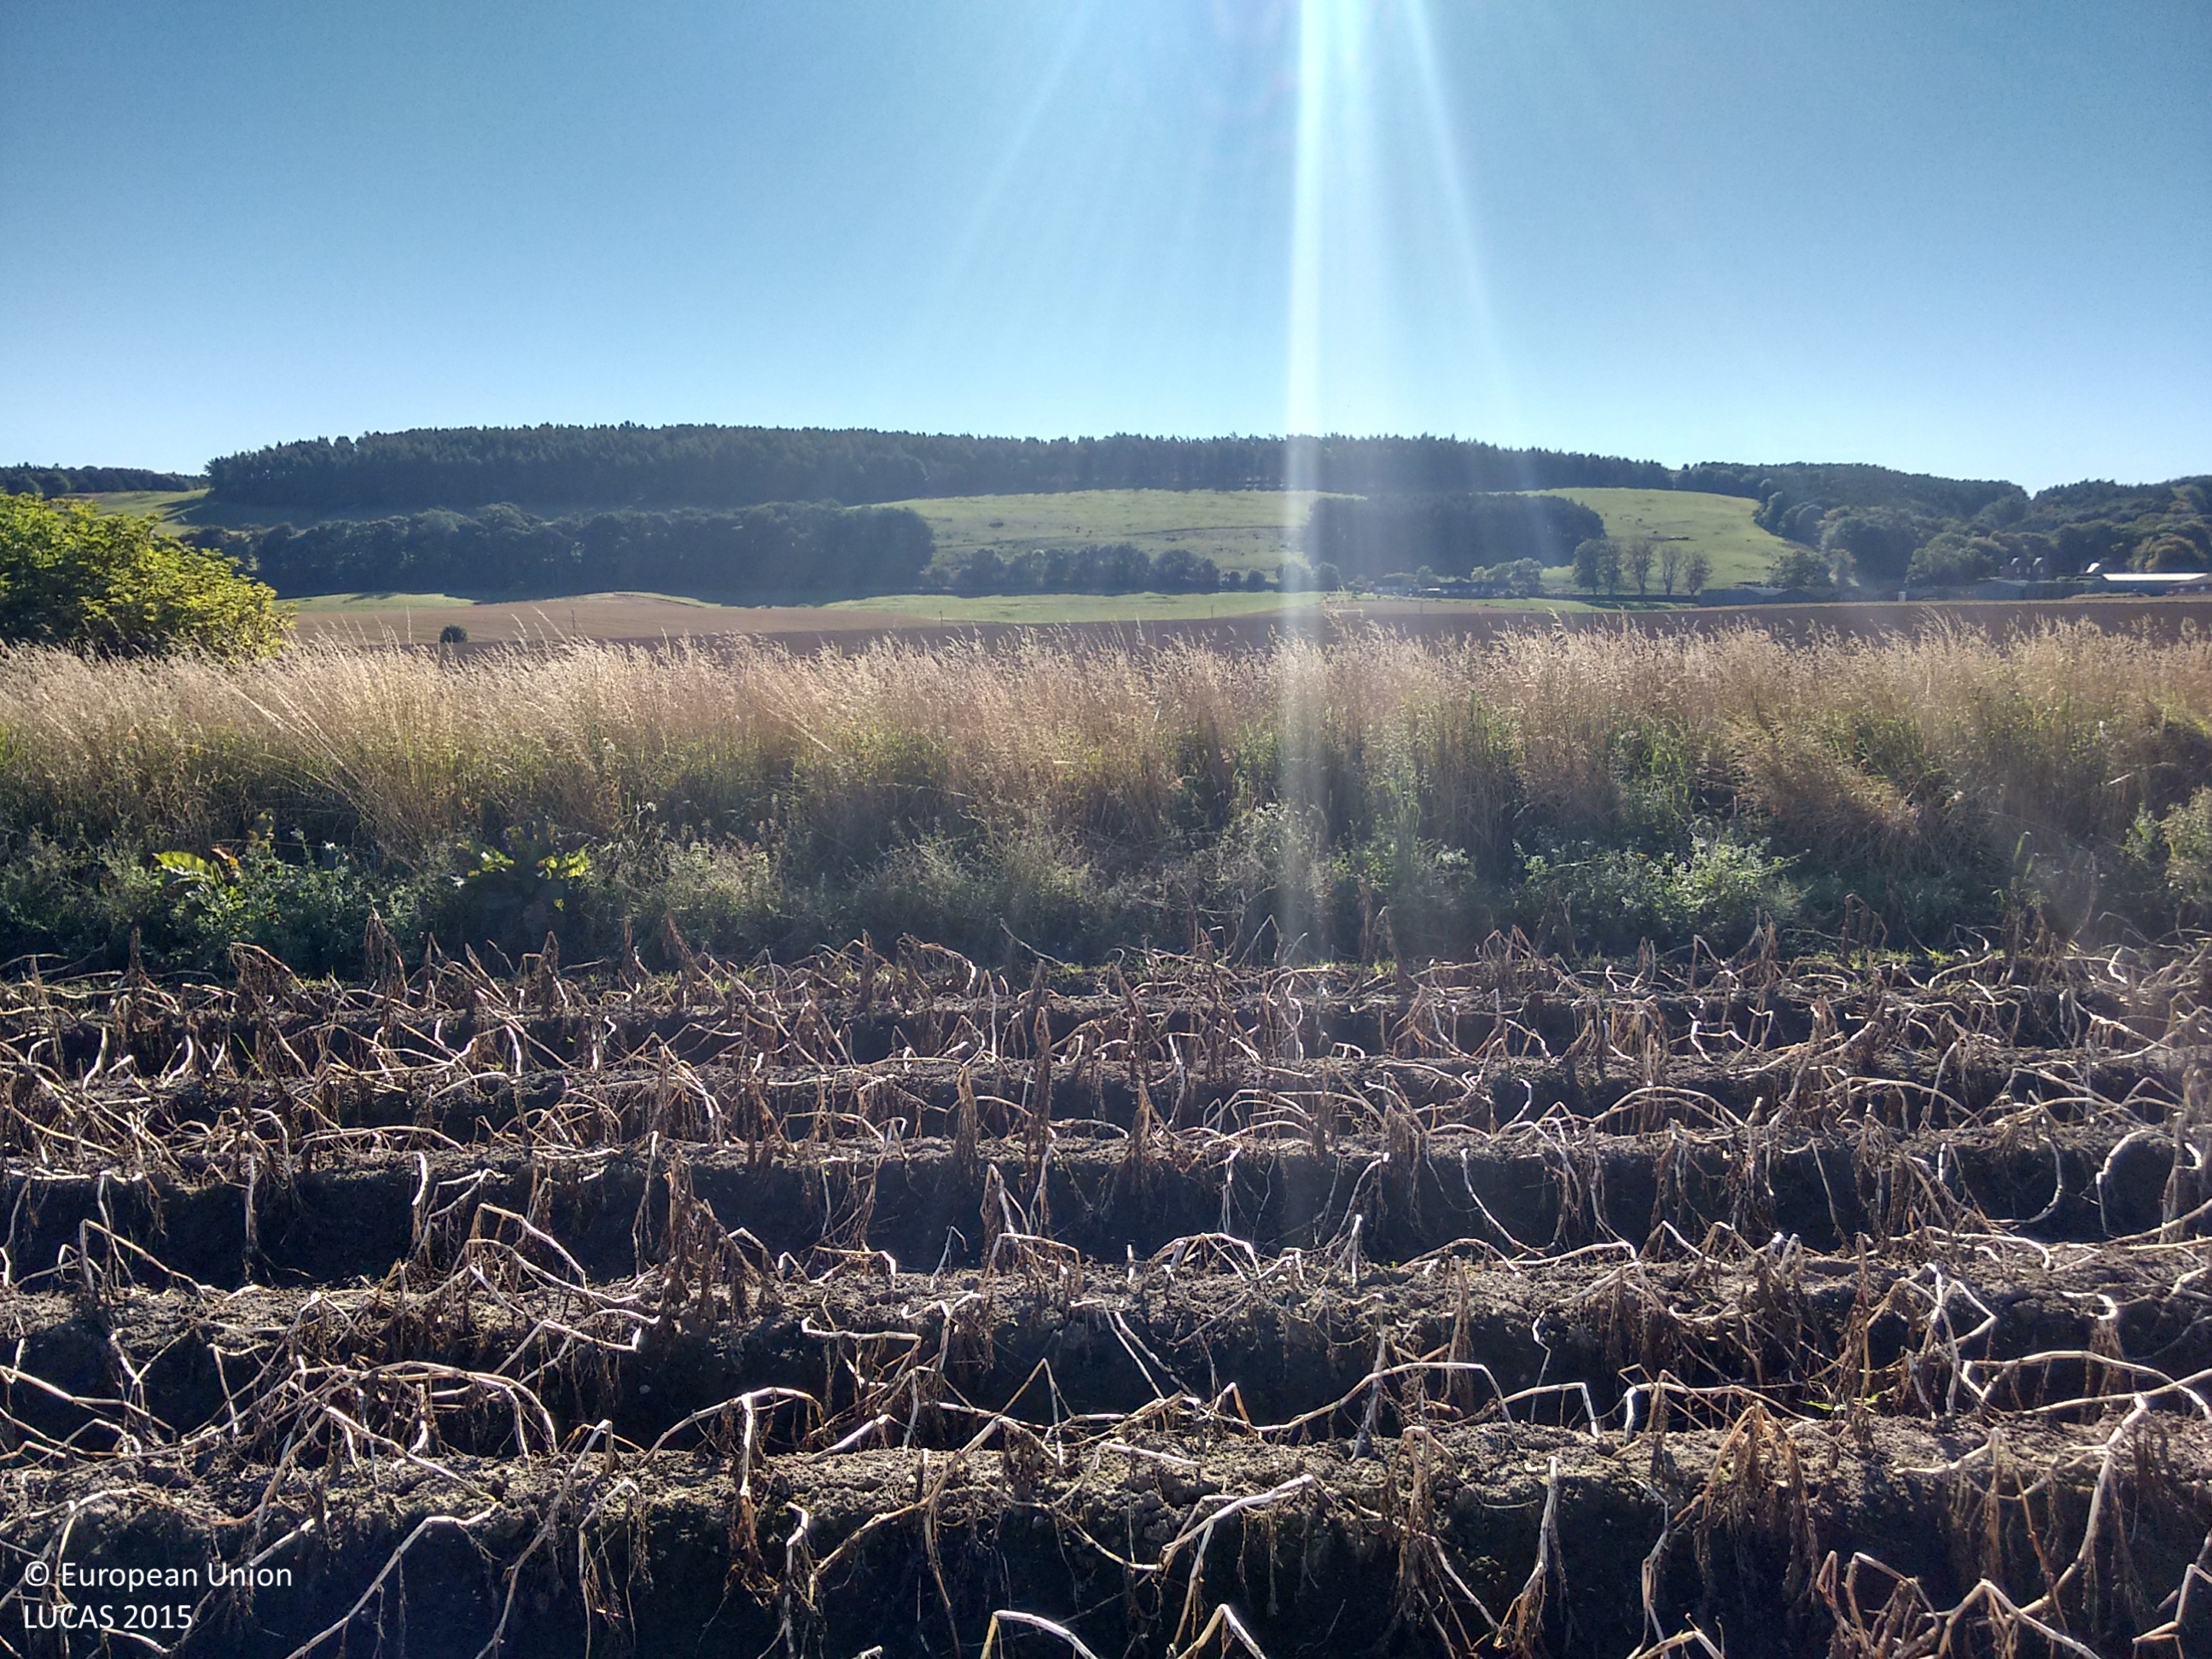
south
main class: Cropland
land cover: Potatoes
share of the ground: > 75 %
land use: Agriculture (excluding fallow land and kitchen gardens)
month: October
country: GB
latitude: 56.6984
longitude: -2.5503
